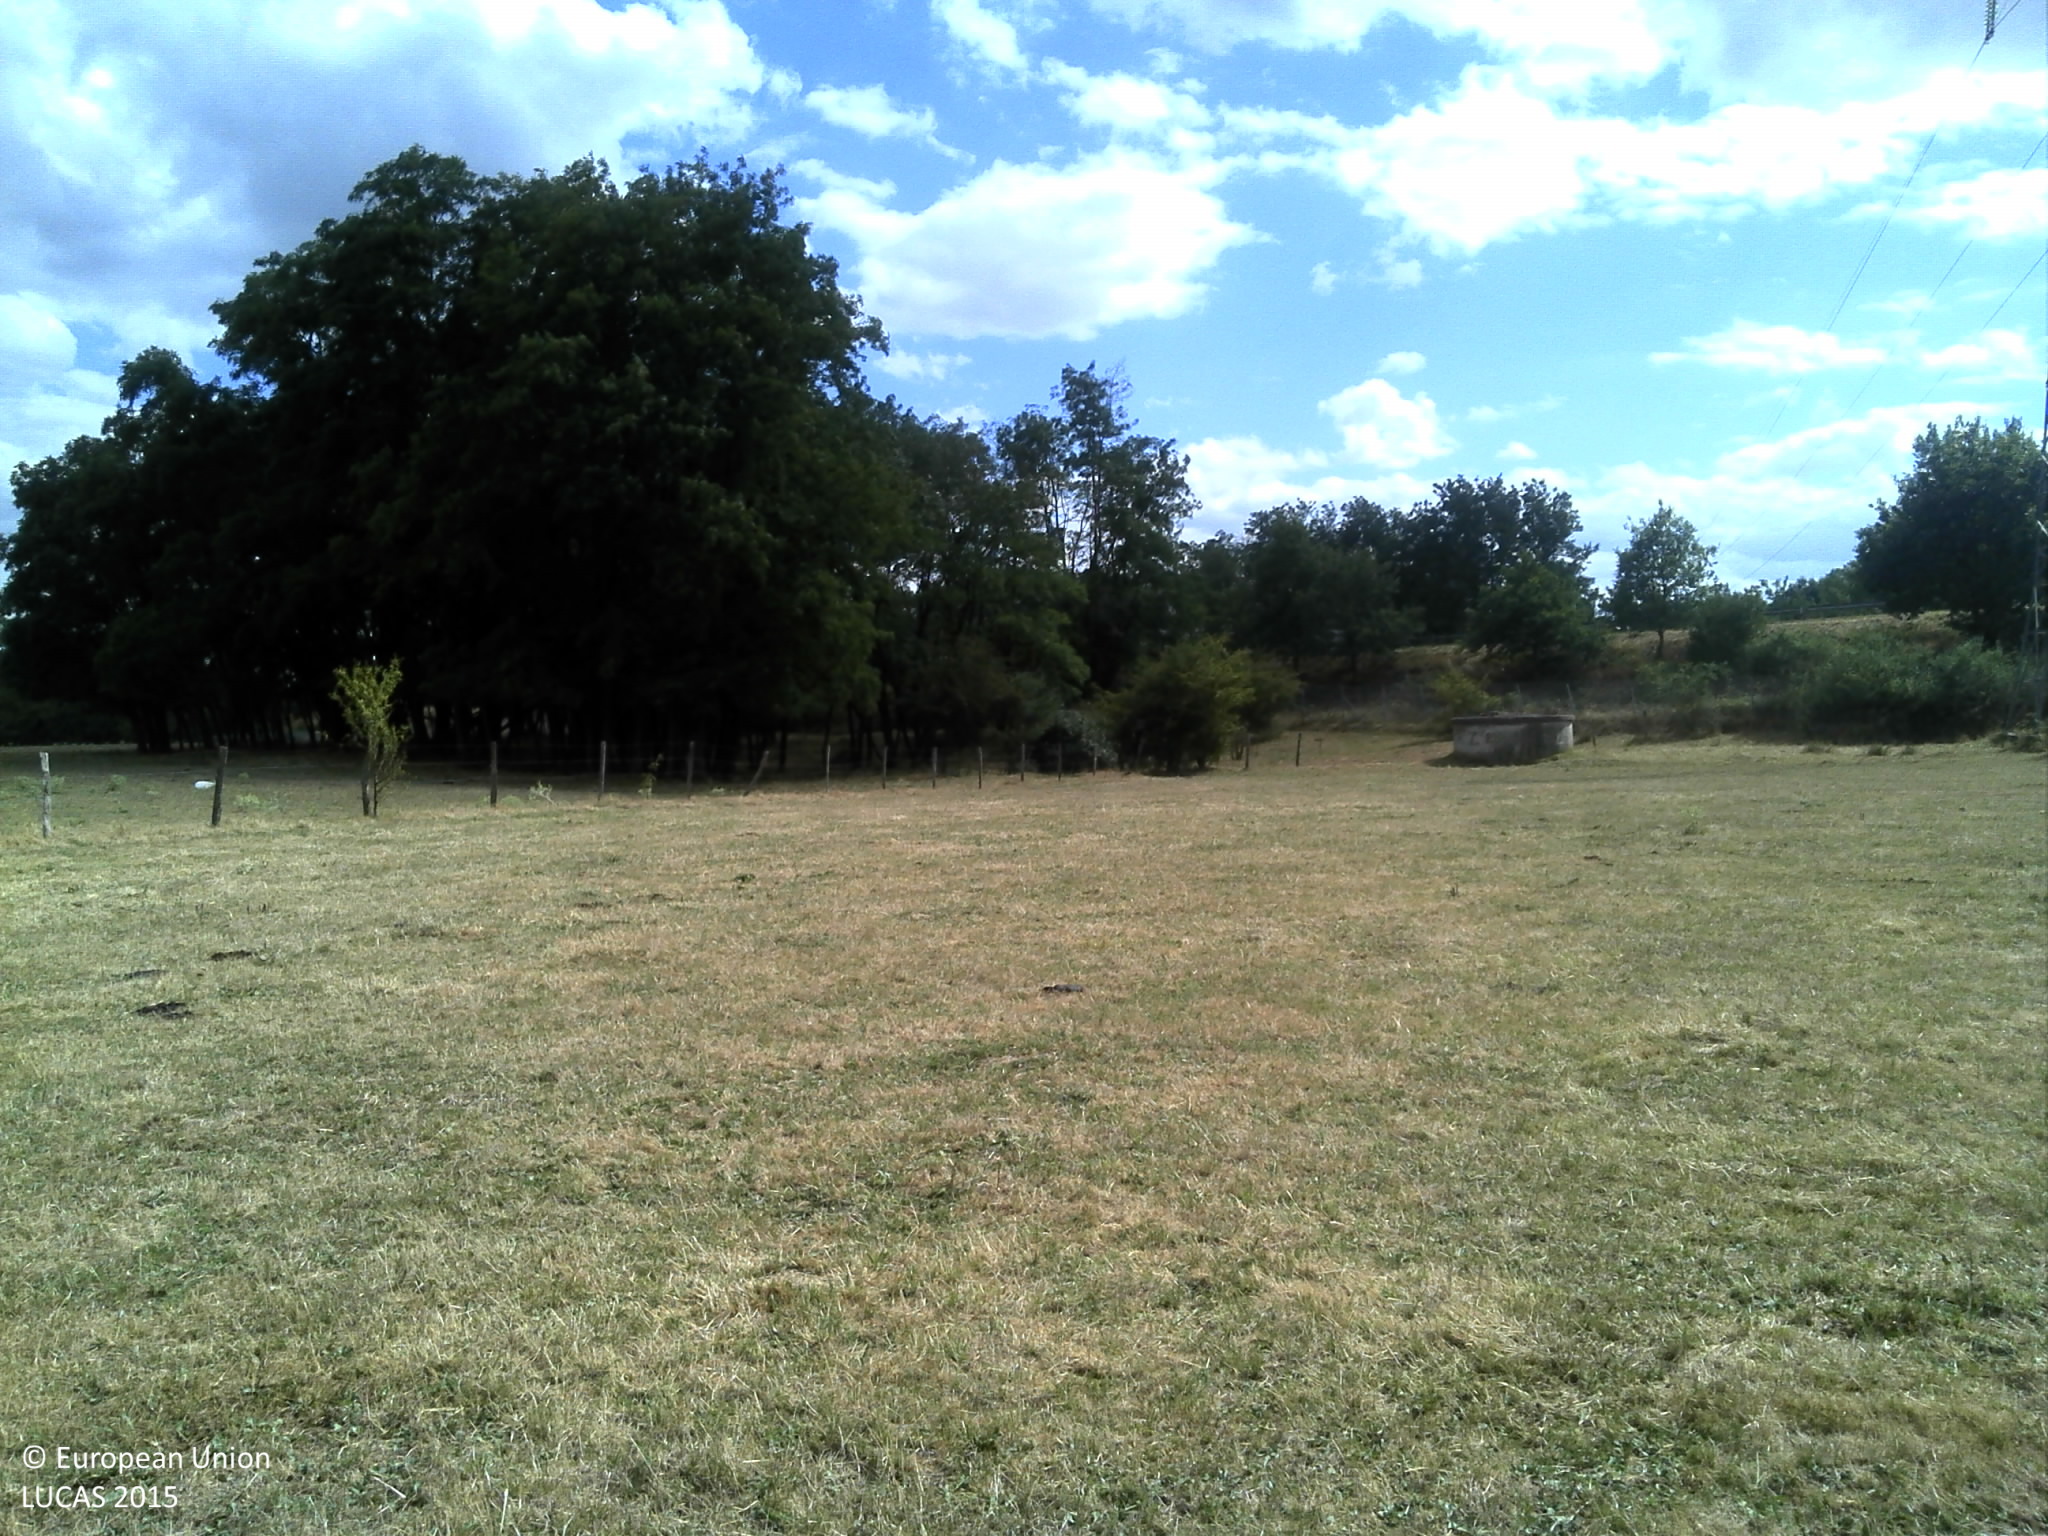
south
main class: Grassland
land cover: Grassland without tree/shrub cover
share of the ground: > 75 %
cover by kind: herbaceous plants 100 %
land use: Agriculture (excluding fallow land and kitchen gardens)
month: July
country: FR
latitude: 46.0436
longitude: 4.0960
